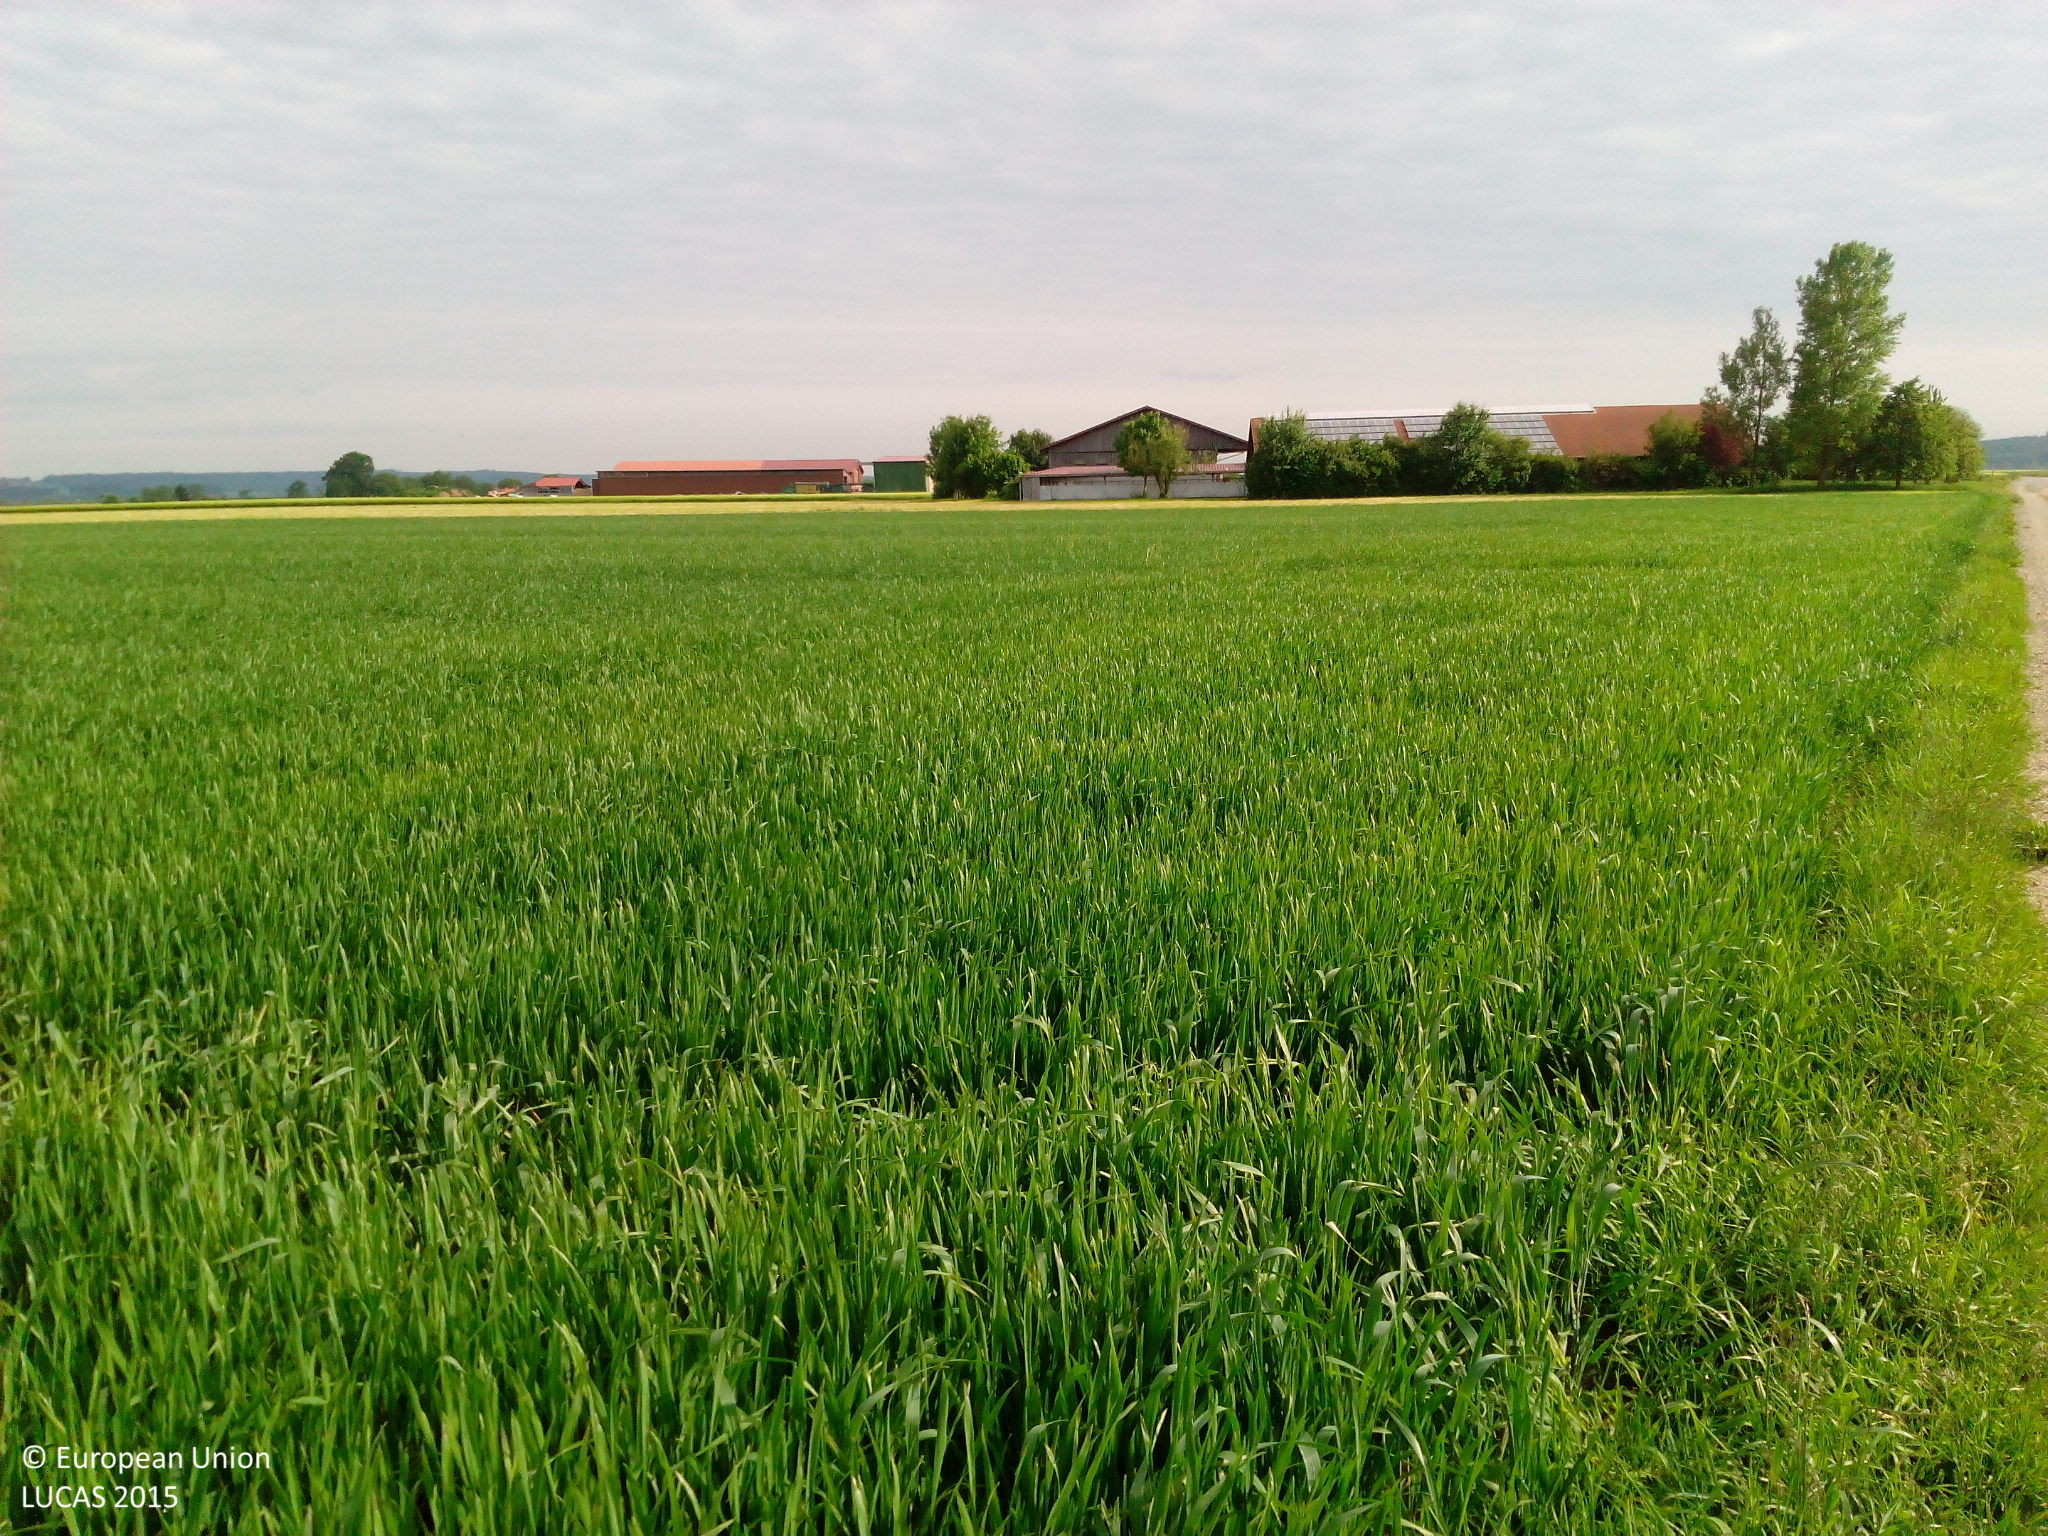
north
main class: Cropland
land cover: Common wheat
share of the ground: > 75 %
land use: Agriculture (excluding fallow land and kitchen gardens)
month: May
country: DE
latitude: 47.9713
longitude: 10.2543
